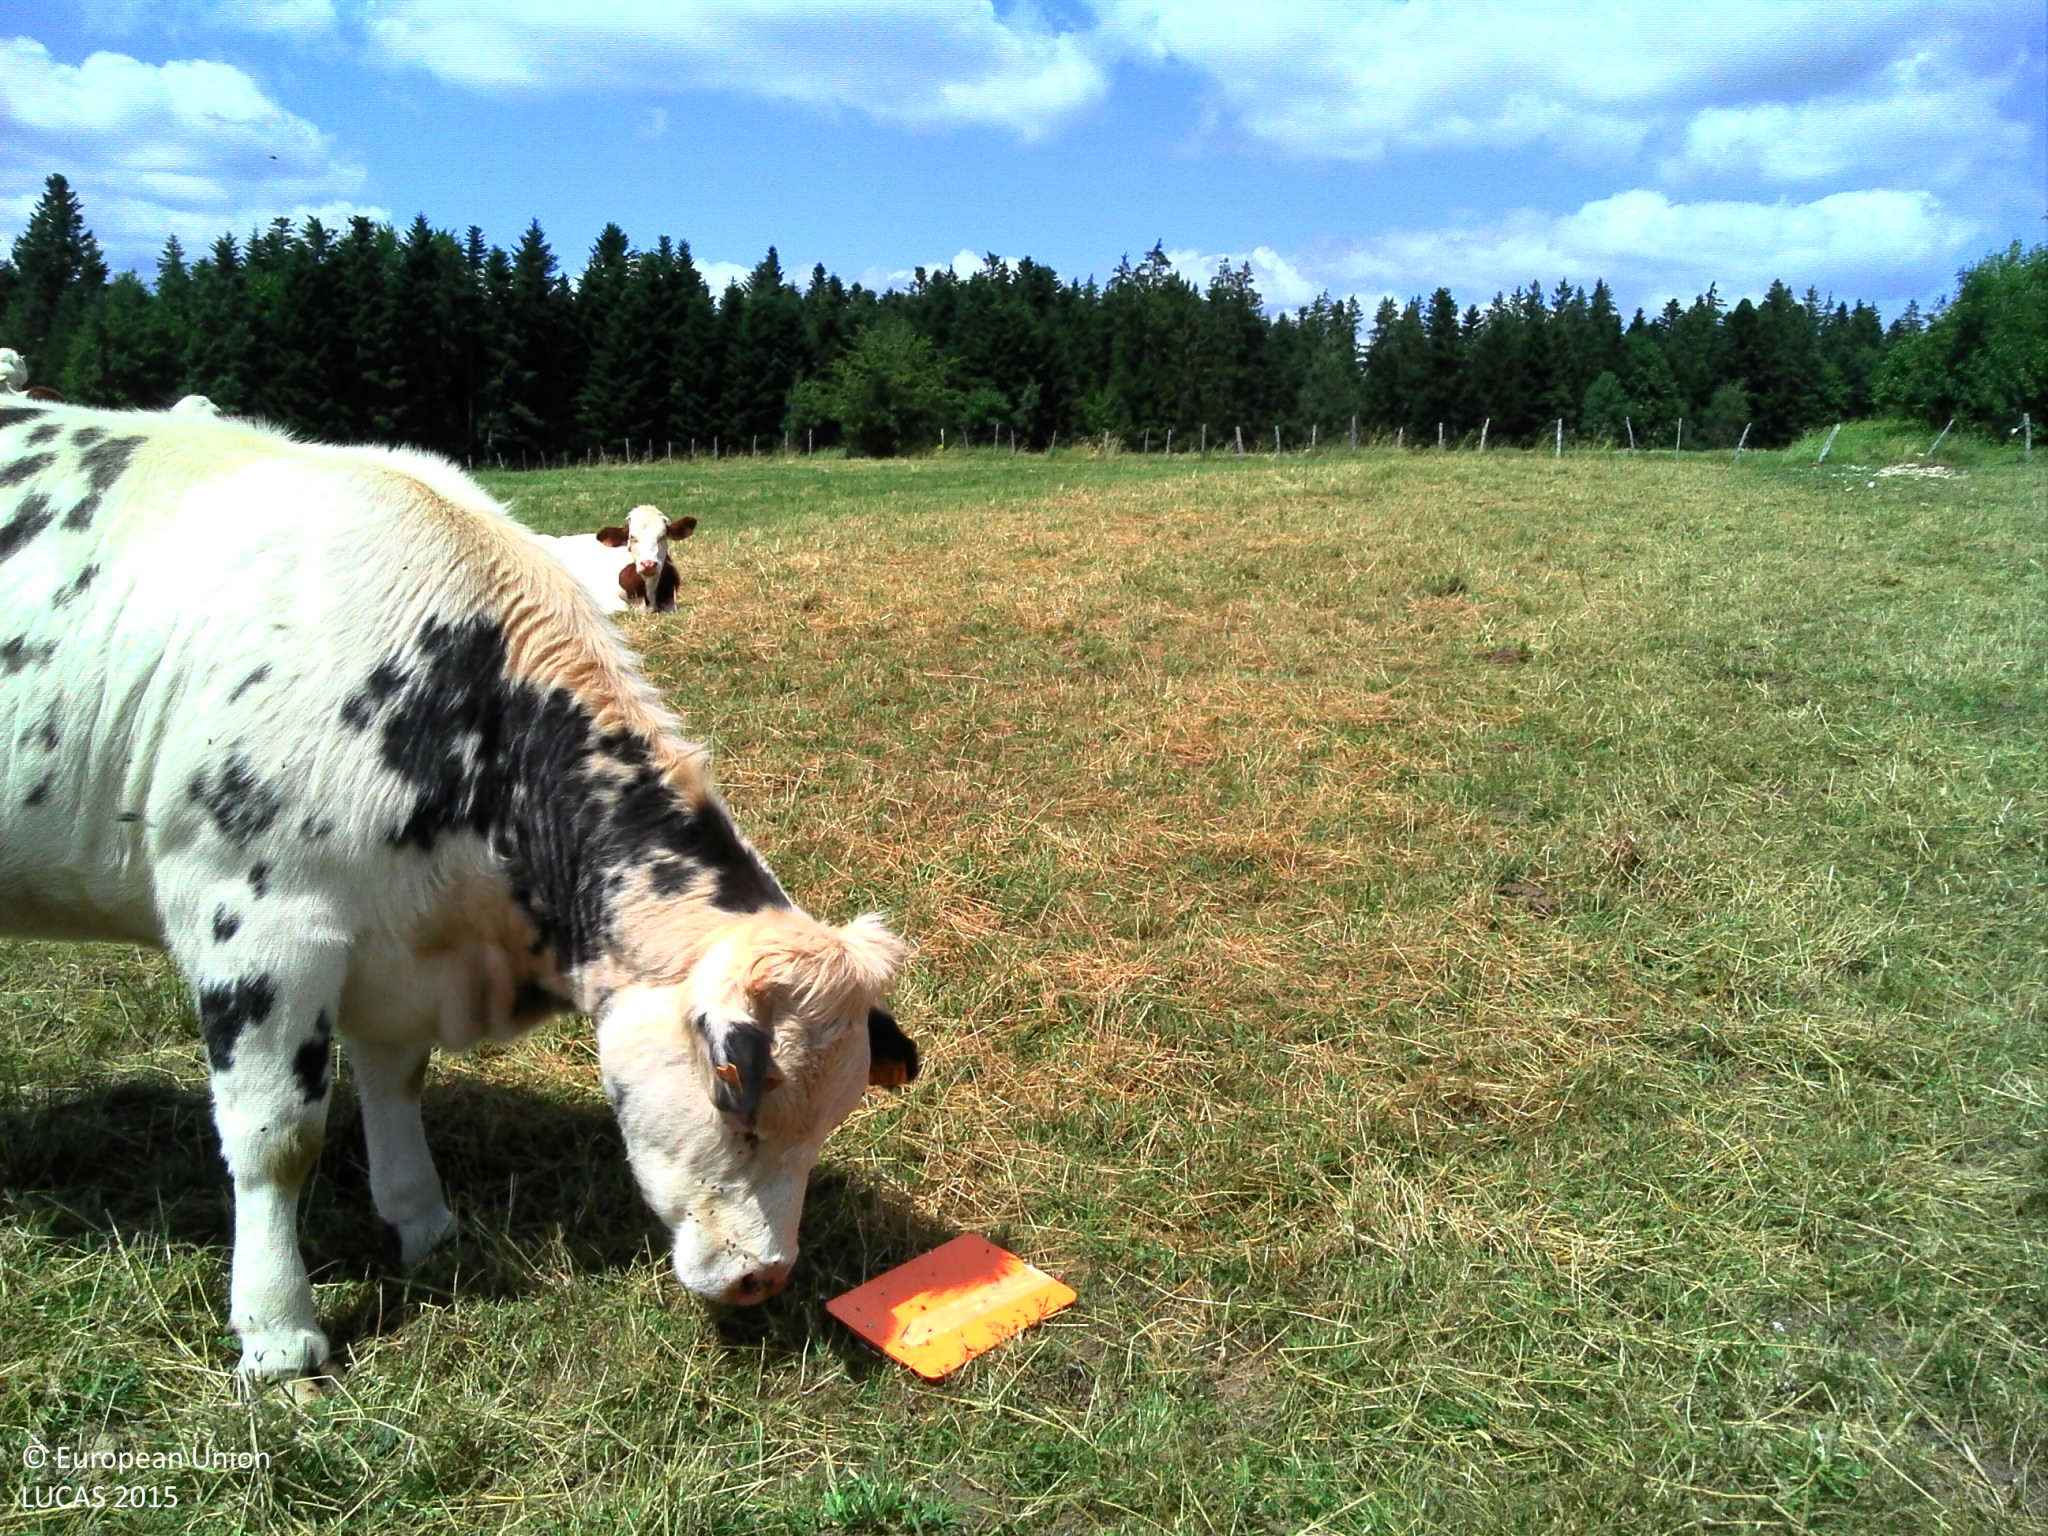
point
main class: Grassland
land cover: Grassland without tree/shrub cover
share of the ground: > 75 %
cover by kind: herbaceous plants 100 %
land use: Agriculture (excluding fallow land and kitchen gardens)
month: July
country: FR
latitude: 46.8374
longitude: 6.0558
